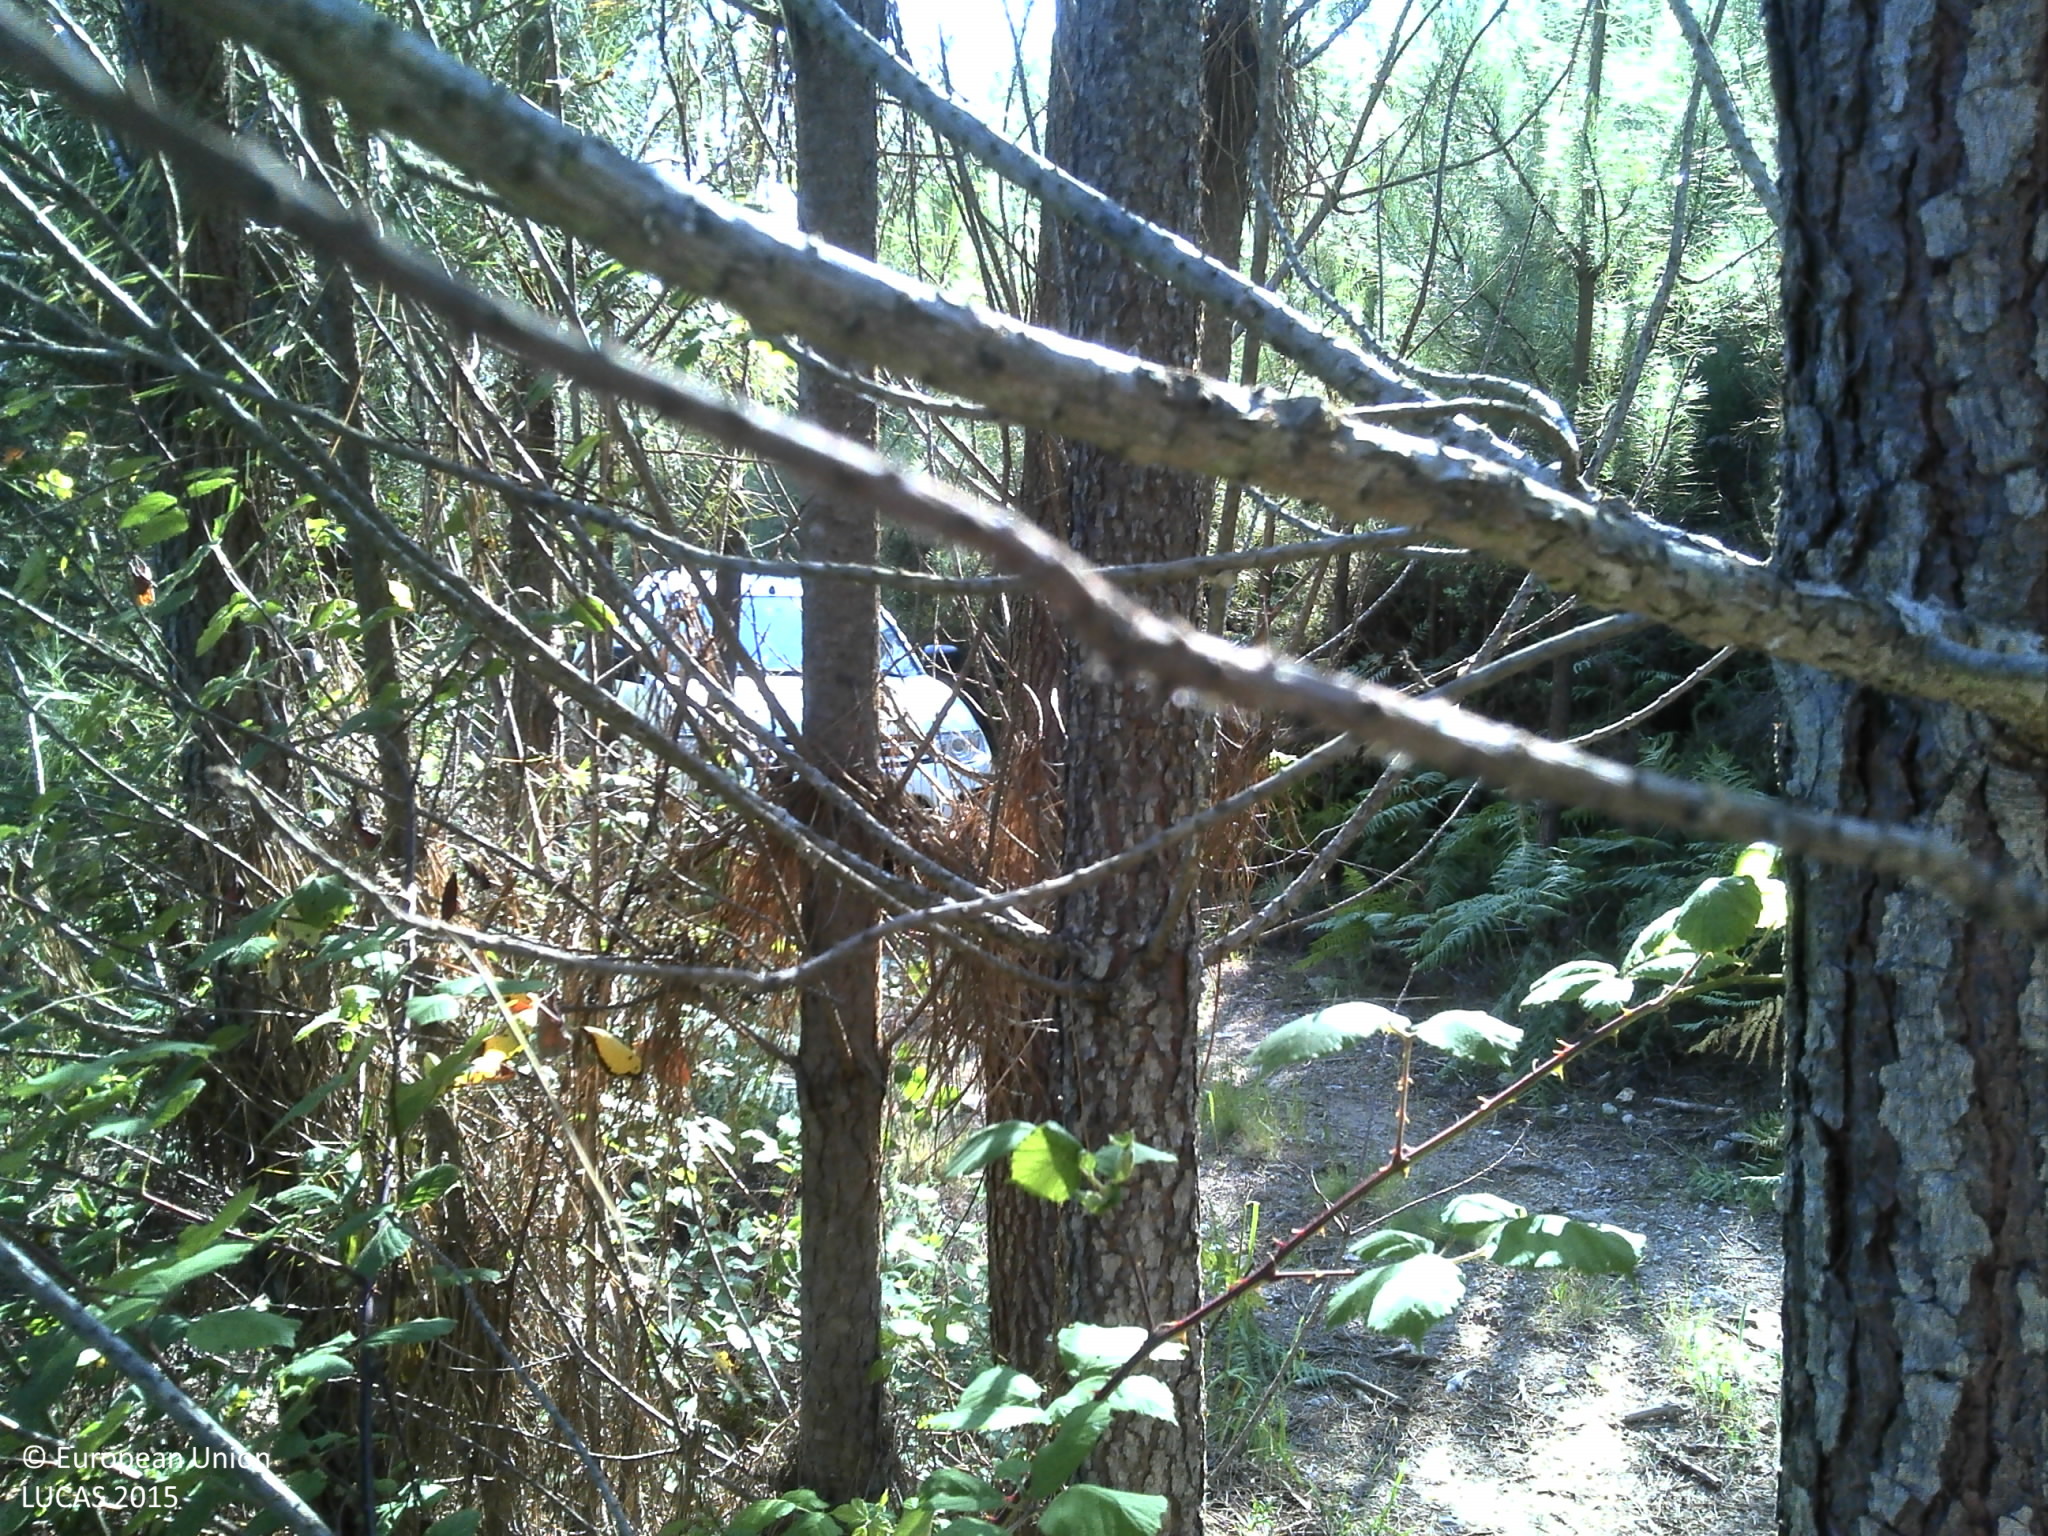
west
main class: Woodland
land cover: Pine dominated coniferous woodland
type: coniferous forest of the mediterranean region
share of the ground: 50 - 75 %
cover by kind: coniferous forest trees 75 %, shrubs 10 %, unconsolidated bare surface 10 %, herbaceous plants 5 %
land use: Forestry
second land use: Agriculture (excluding fallow land and kitchen gardens)
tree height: > 5 m
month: June
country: PT
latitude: 42.0559
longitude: -8.3202
